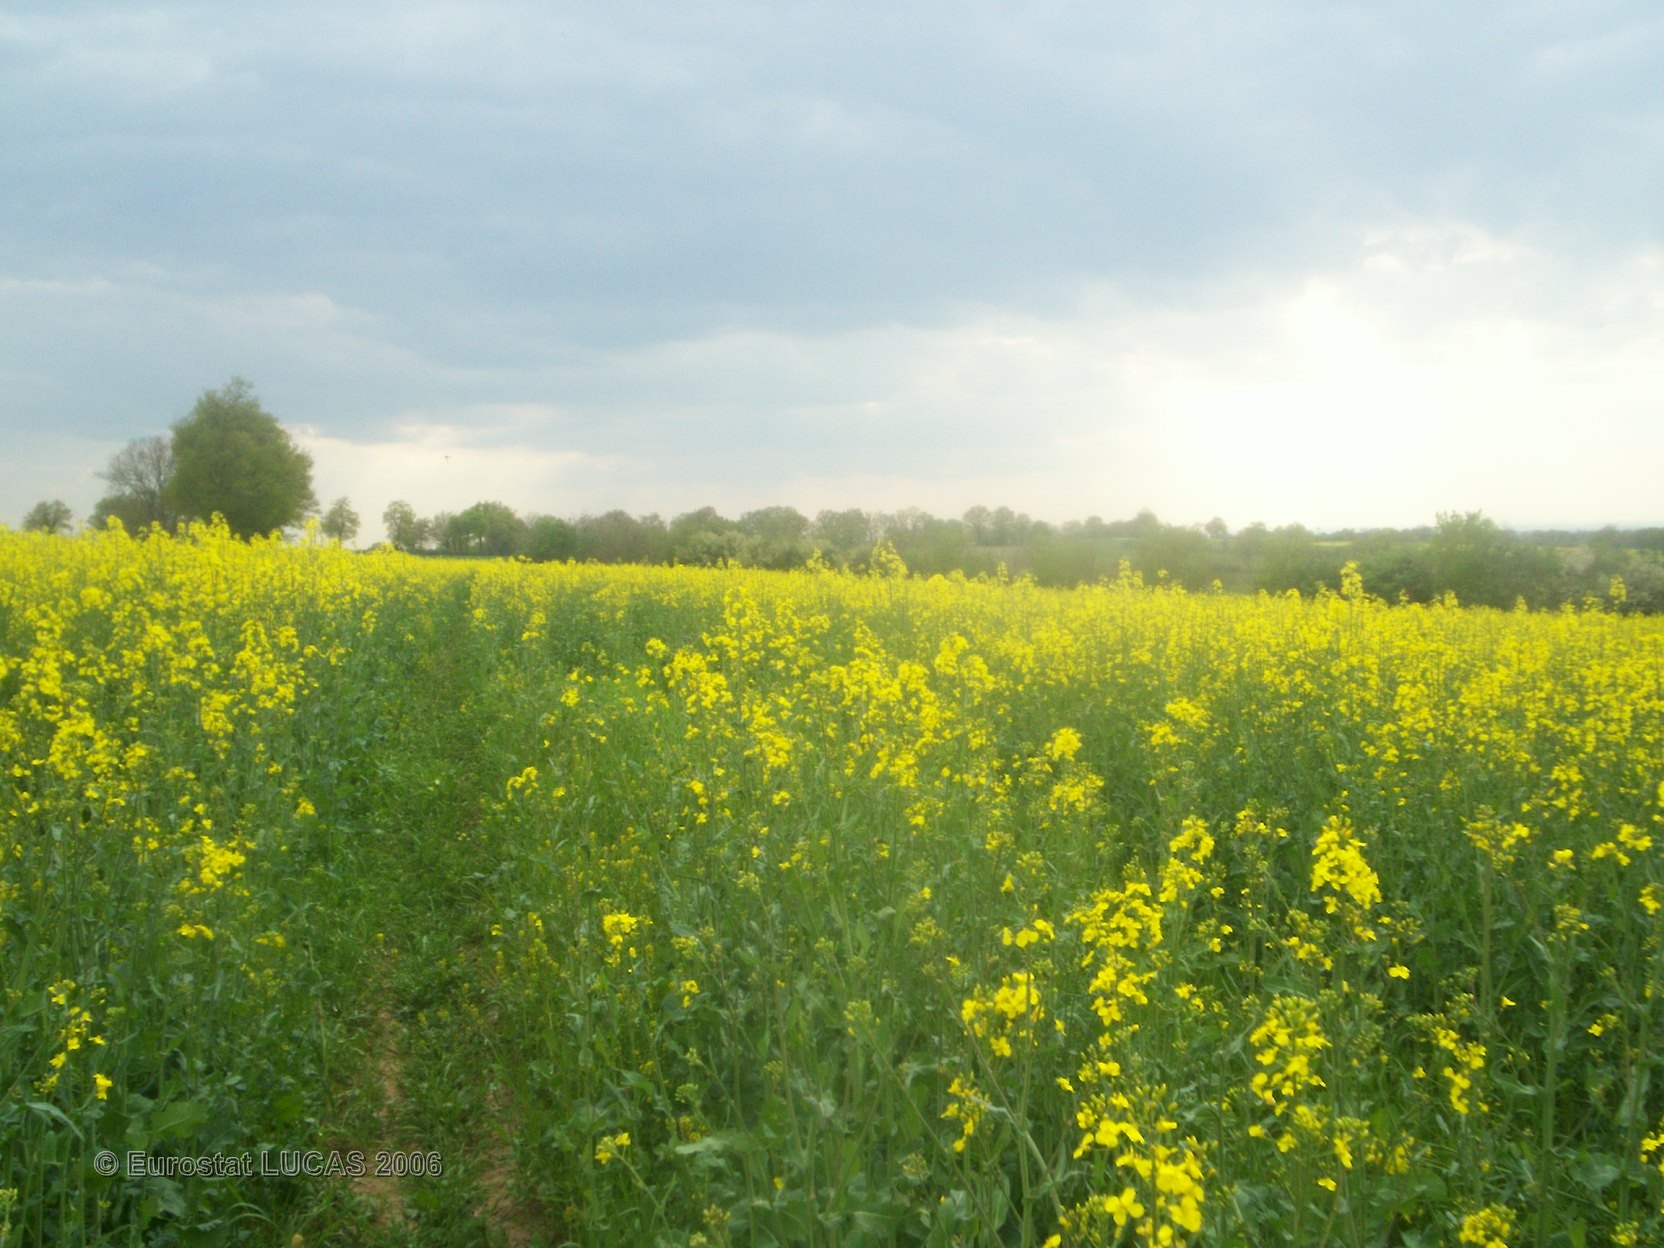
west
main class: Cropland
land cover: Rape and turnip rape
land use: Agriculture (excluding fallow land and kitchen gardens)
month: May
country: FR
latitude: 46.4705
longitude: 3.0822
